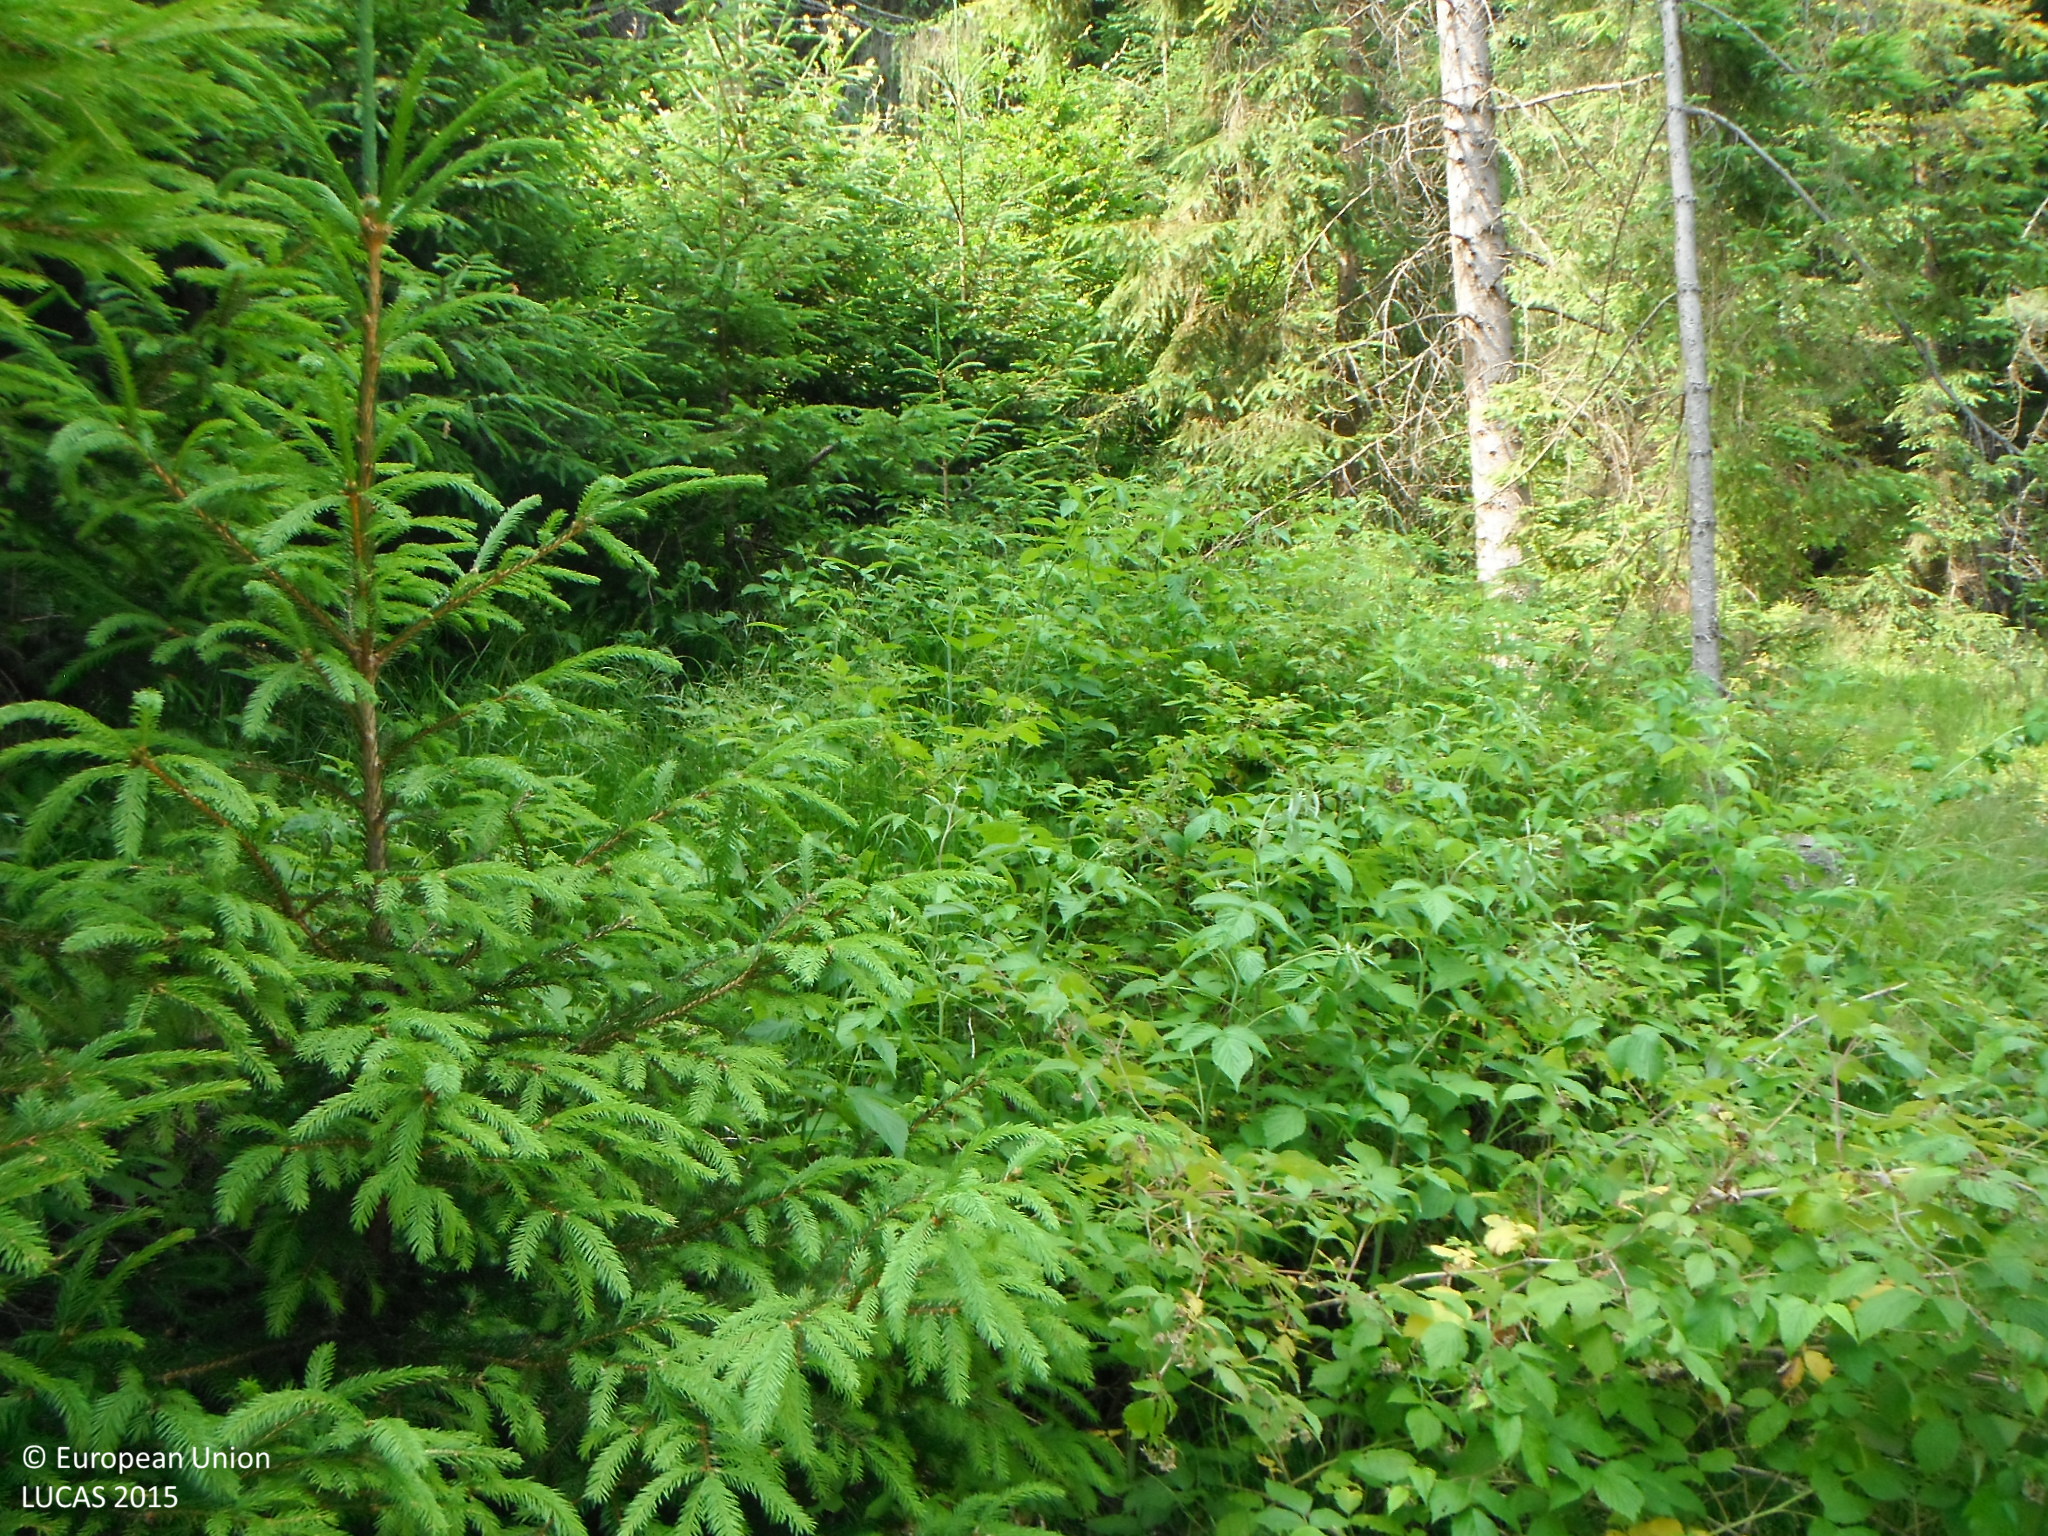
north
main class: Woodland
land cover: Spruce dominated coniferous woodland
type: alpine coniferous forest
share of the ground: > 75 %
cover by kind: coniferous forest trees 80 %, shrubs 10 %, herbaceous plants 10 %
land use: Forestry
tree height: > 5 m
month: July
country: SK
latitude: 49.4782
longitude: 19.5086
